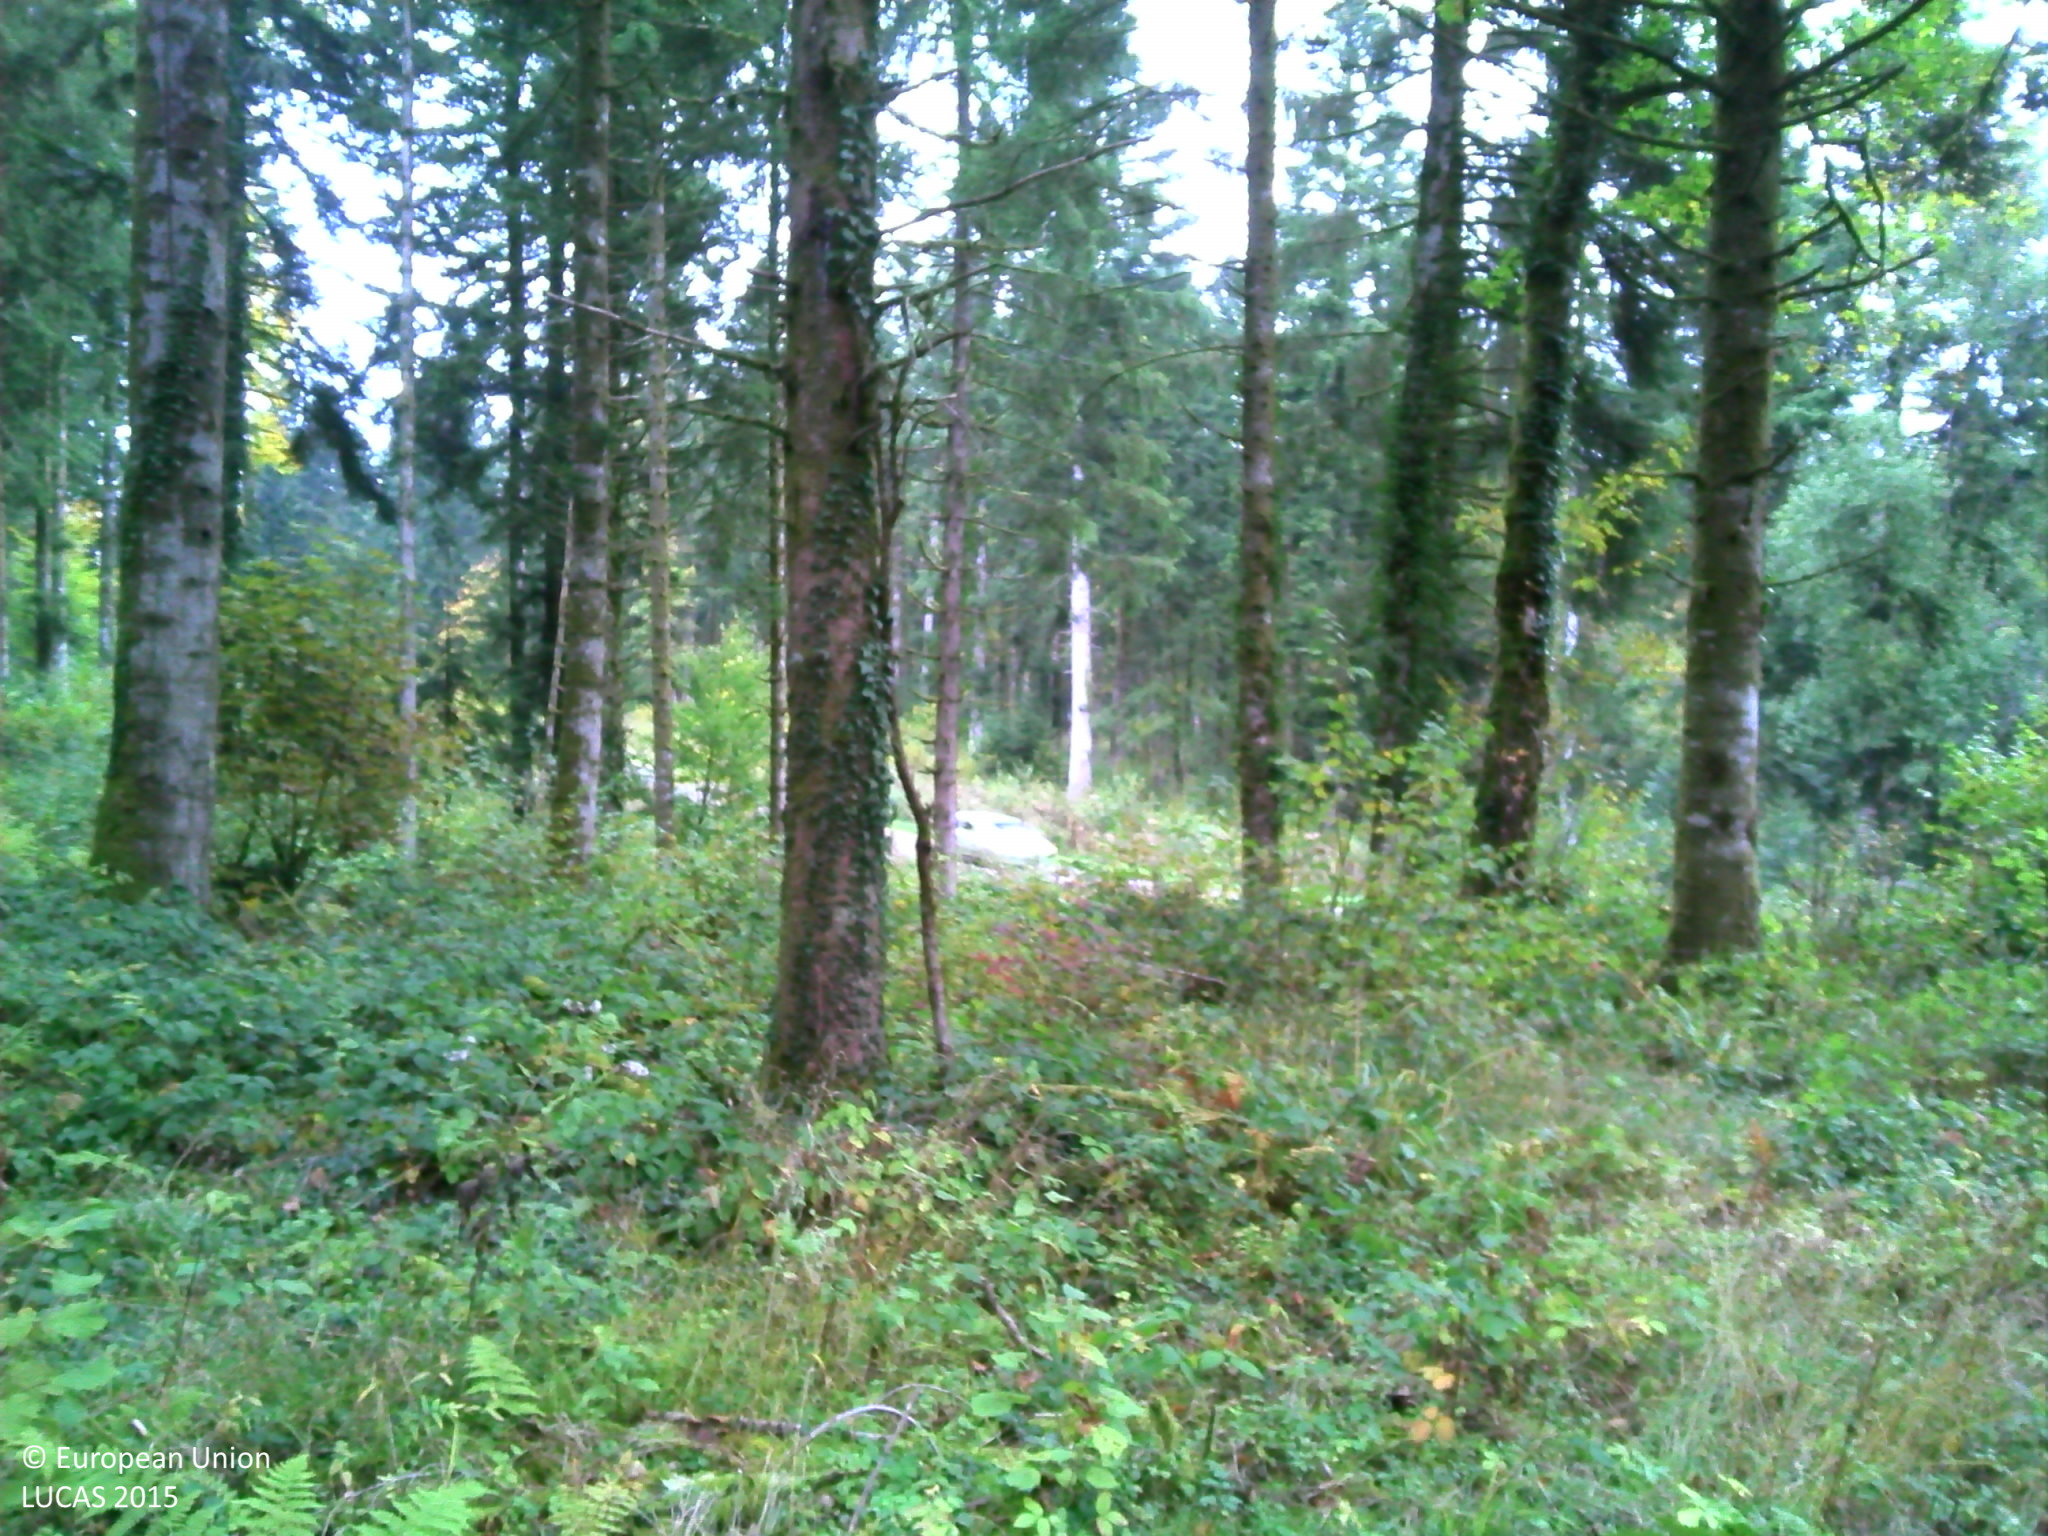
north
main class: Woodland
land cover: Spruce dominated mixed woodland
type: mountainous beech forest
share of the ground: > 75 %
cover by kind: coniferous forest trees 45 %, broadleaved forest trees 30 %, shrubs 15 %, herbaceous plants 10 %
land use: Forestry
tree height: > 5 m
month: October
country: FR
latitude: 46.9273
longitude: 6.0491
